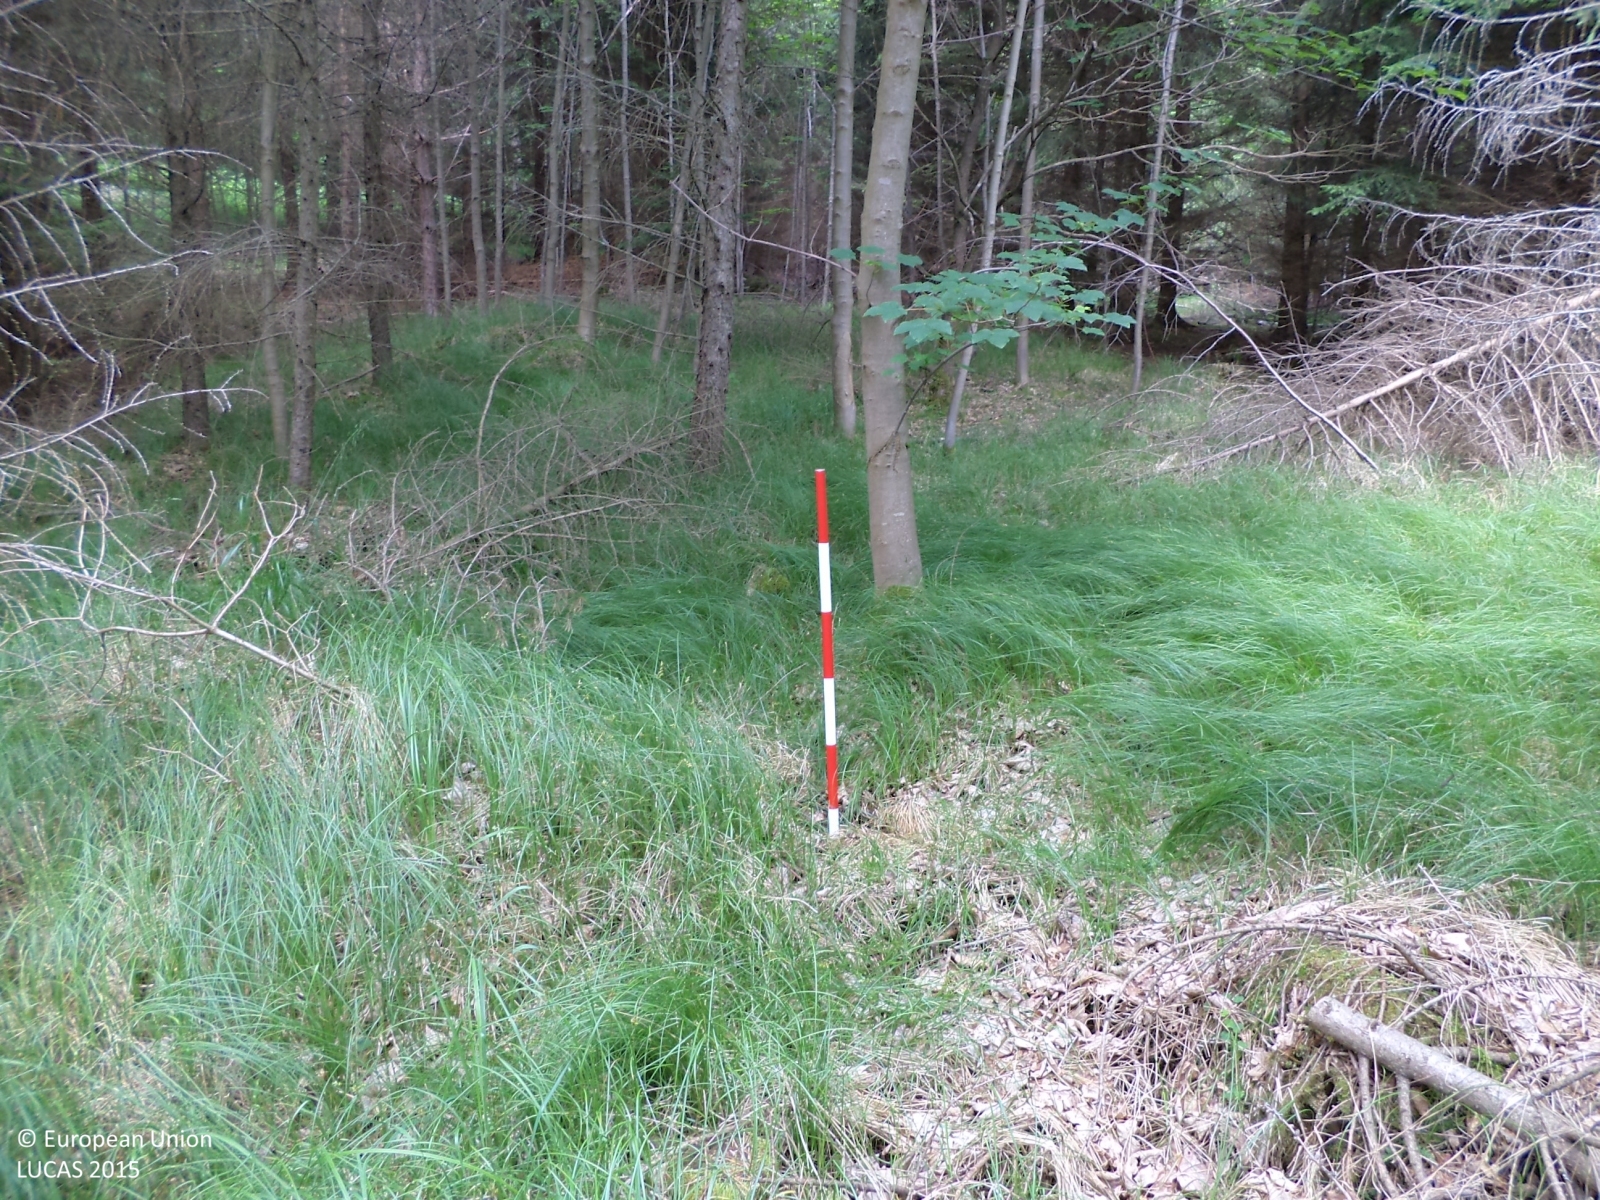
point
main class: Woodland
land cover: Pine dominated mixed woodland
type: hemiboreal forest and nemoral coniferous forest and mixed broadleaved-coniferous forest
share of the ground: > 75 %
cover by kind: coniferous forest trees 50 %, broadleaved forest trees 40 %, herbaceous plants 10 %
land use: Forestry
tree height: > 5 m
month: June
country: CZ
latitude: 49.1436
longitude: 14.4290
